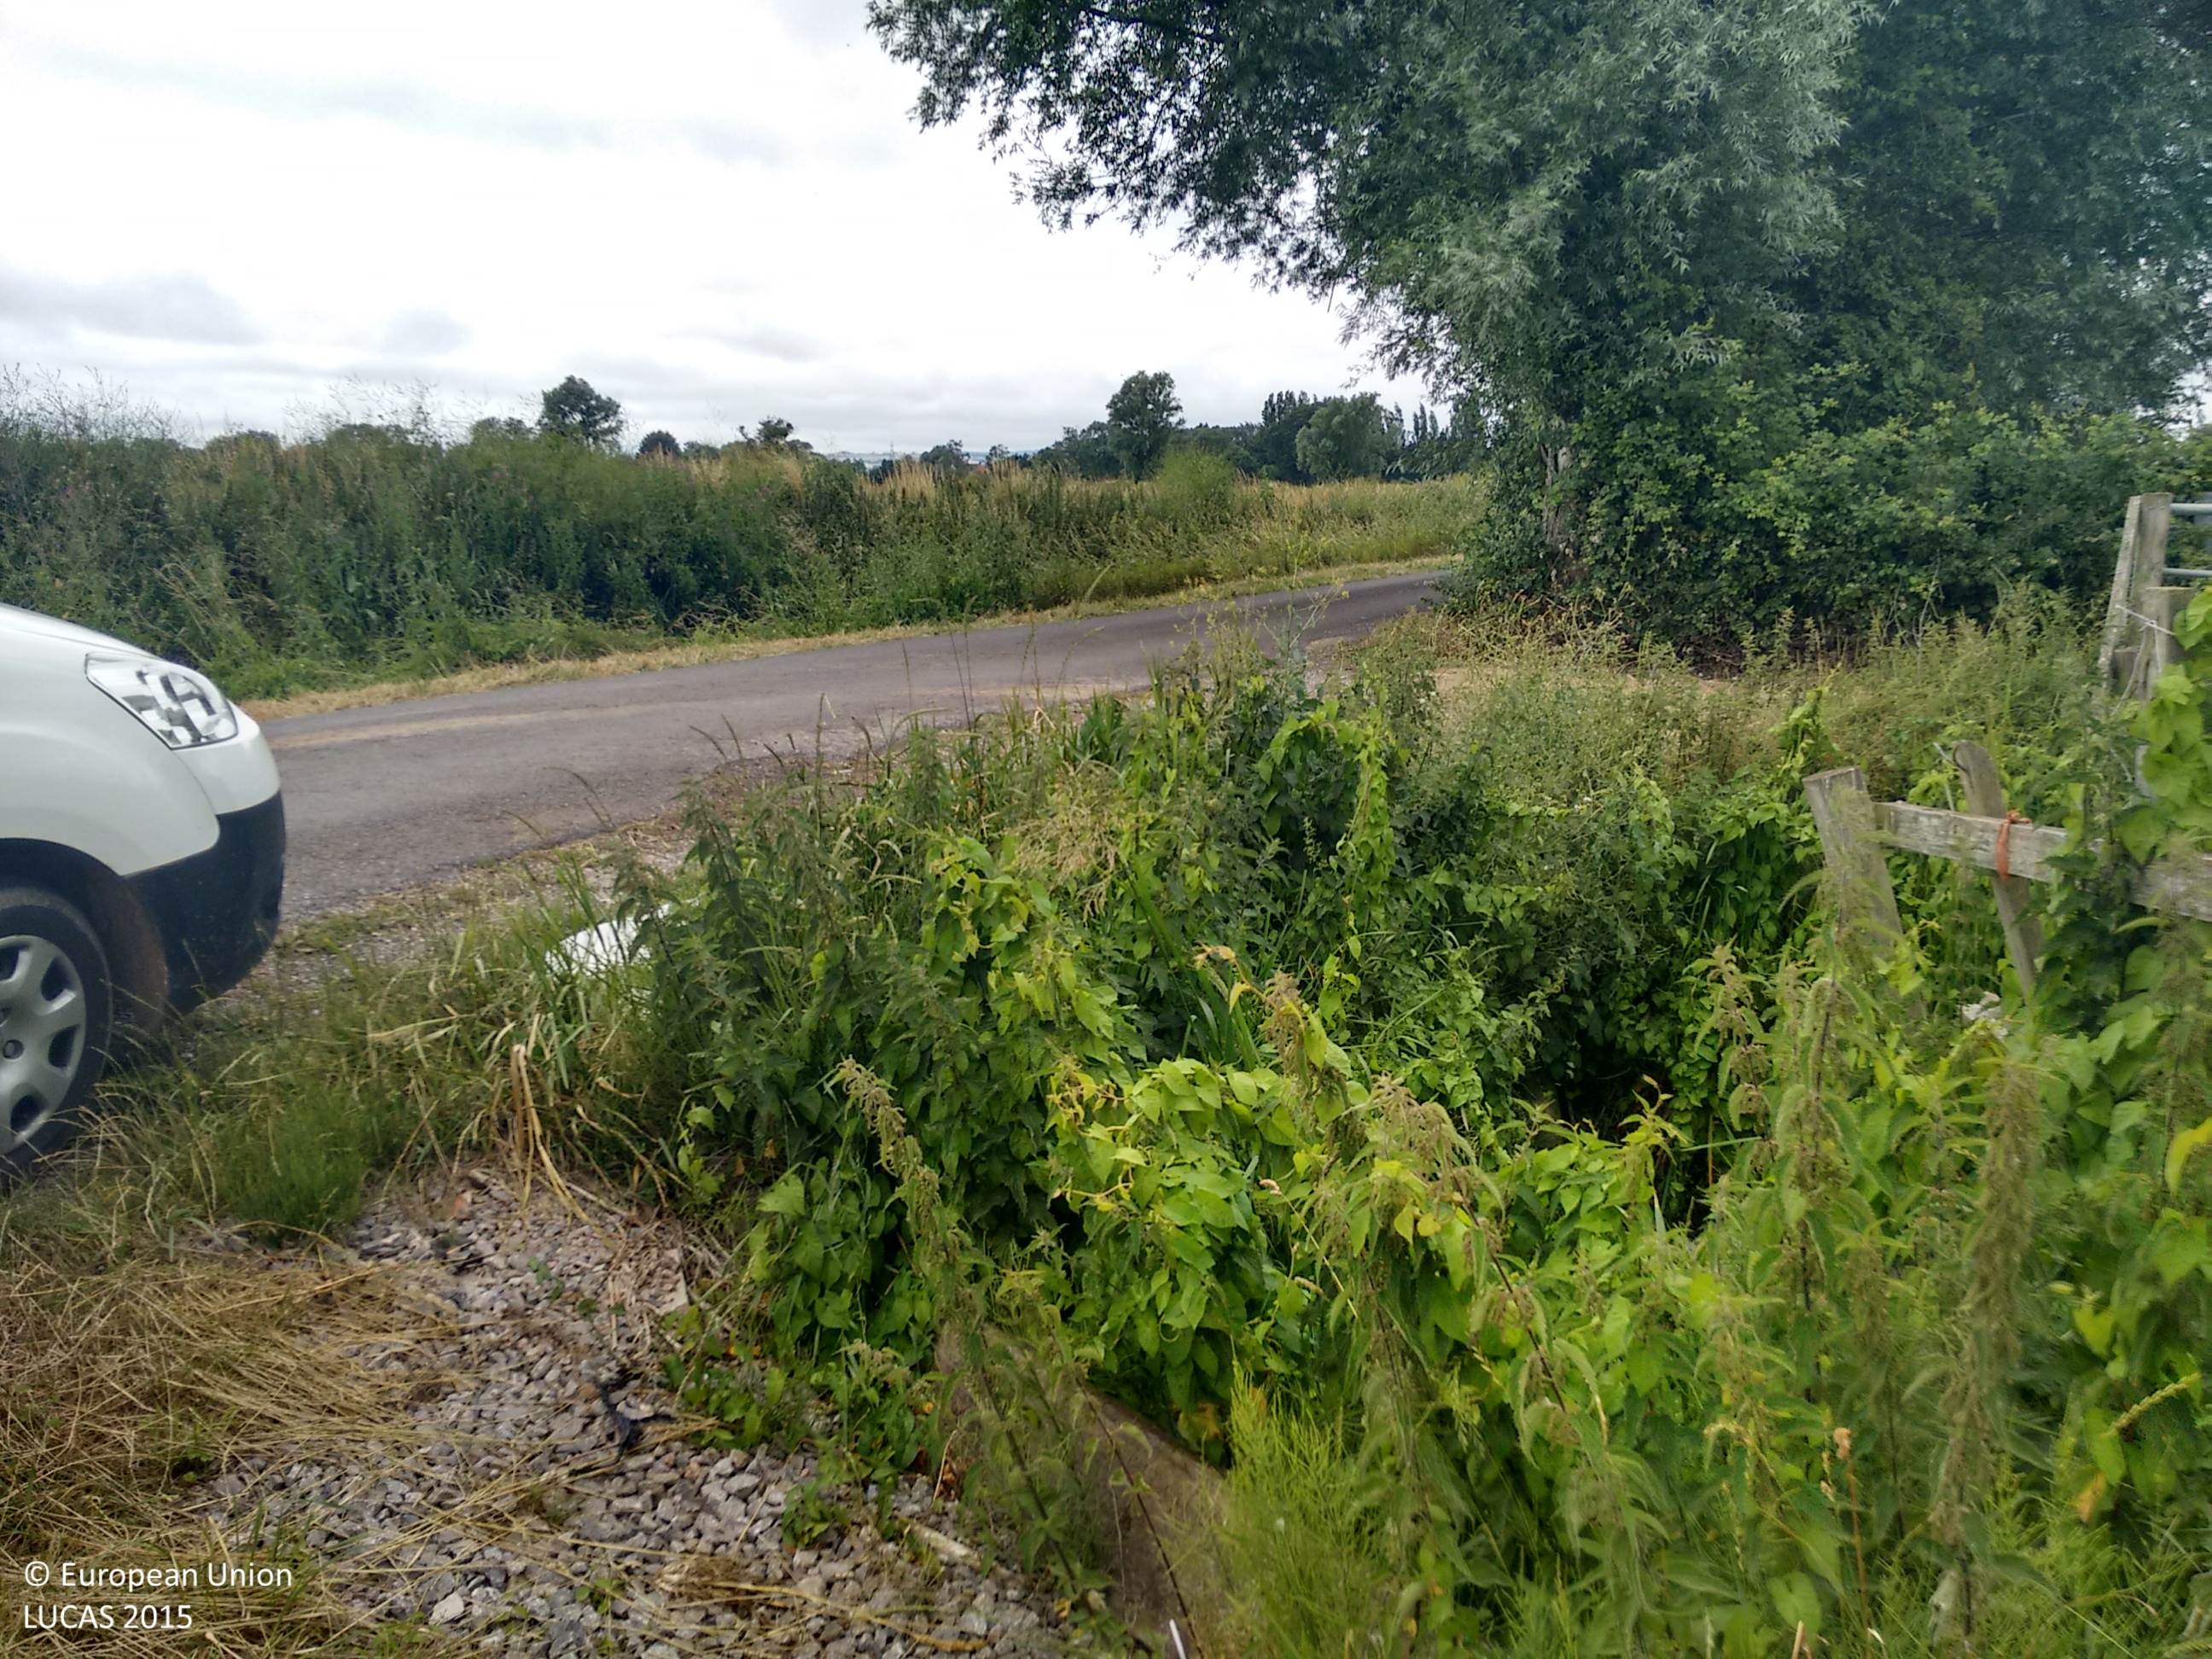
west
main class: Cropland
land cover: Temporary grasslands
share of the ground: > 75 %
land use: Agriculture (excluding fallow land and kitchen gardens)
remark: Harvested field
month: July
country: GB
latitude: 51.1006
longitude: -2.9408
